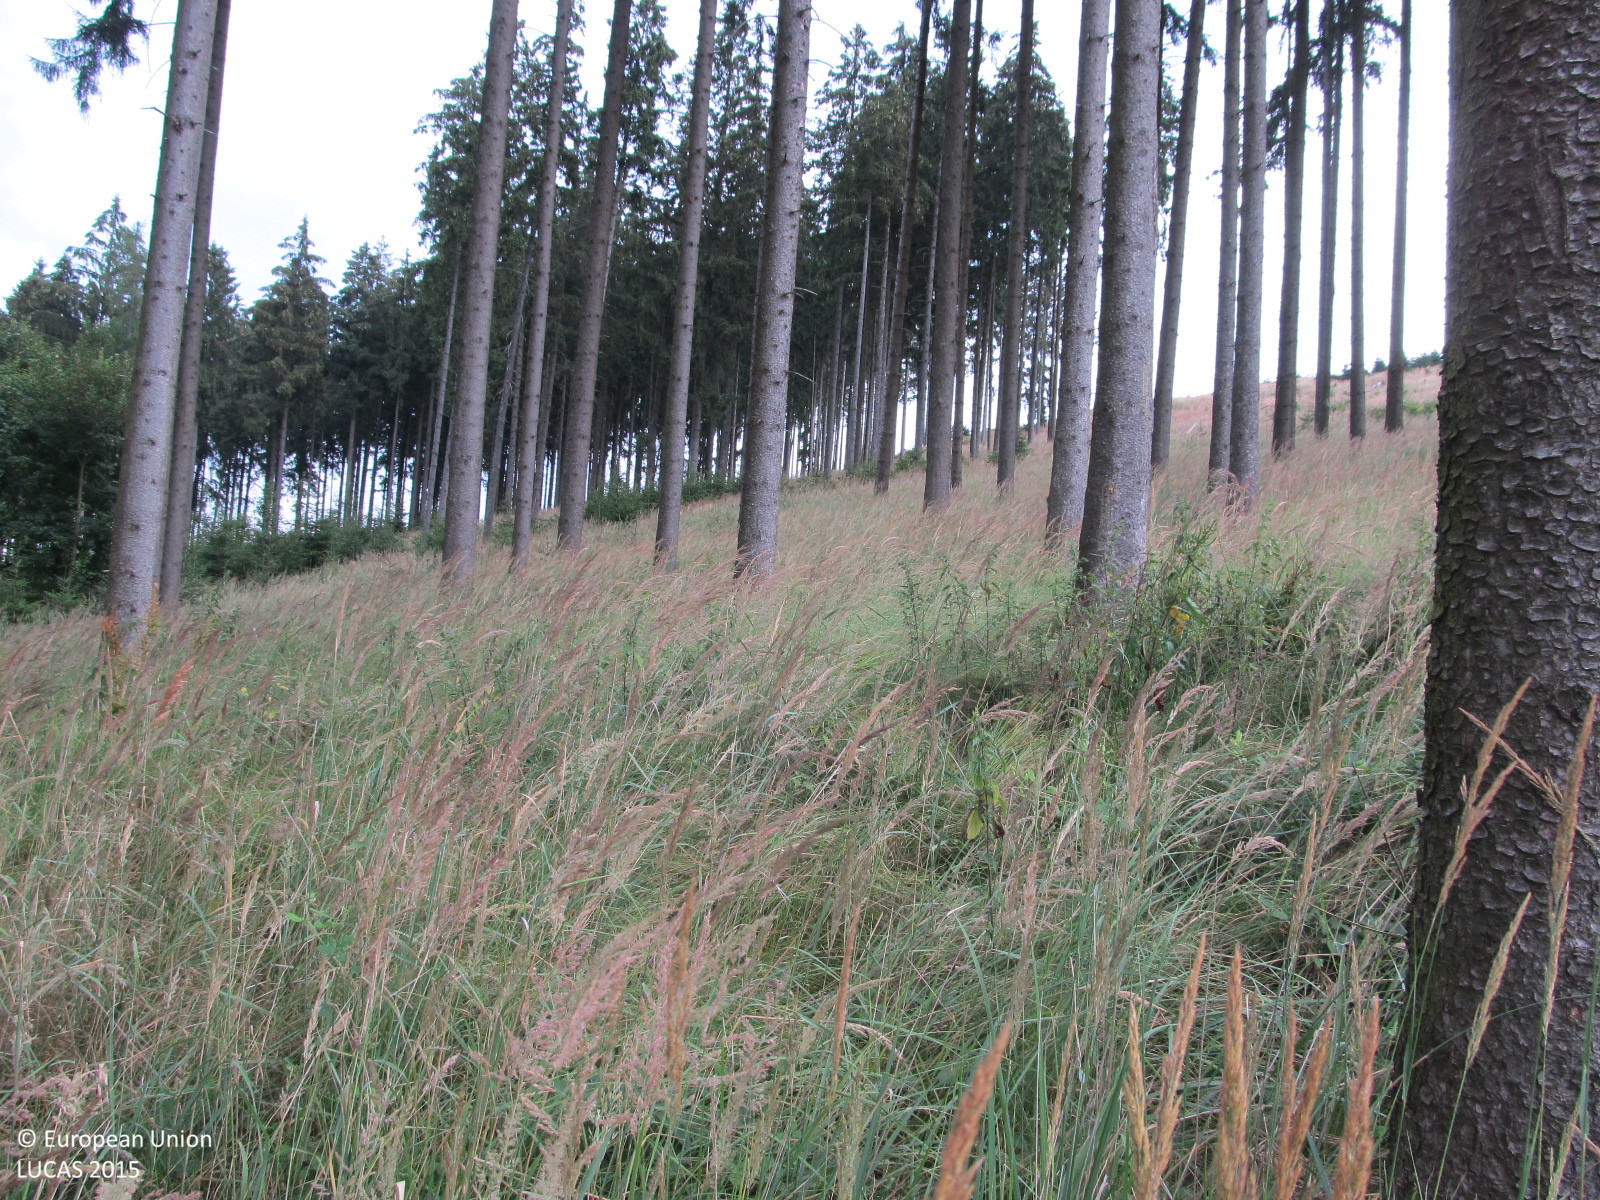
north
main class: Woodland
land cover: Spruce dominated coniferous woodland
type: hemiboreal forest and nemoral coniferous forest and mixed broadleaved-coniferous forest
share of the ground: 50 - 75 %
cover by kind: coniferous forest trees 75 %, herbaceous plants 25 %
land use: Forestry
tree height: > 5 m
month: July
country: AT
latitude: 48.2494
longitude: 15.4836
